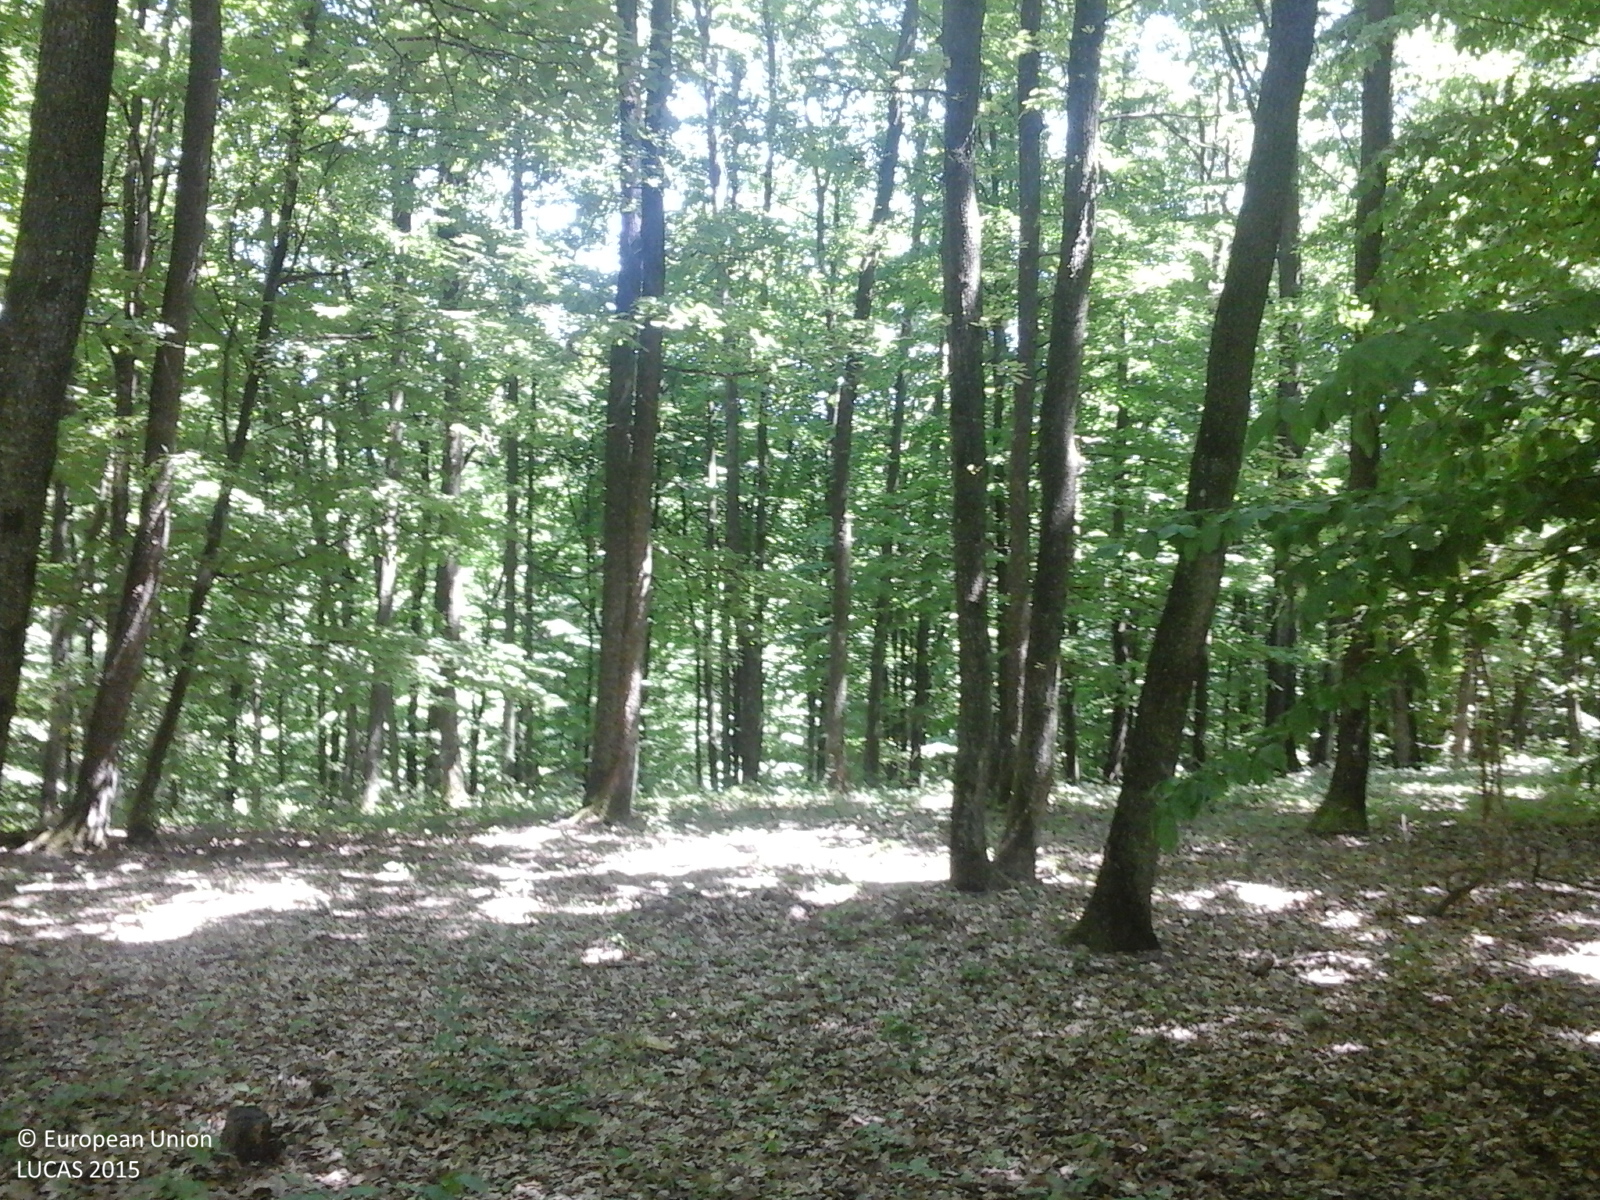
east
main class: Woodland
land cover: Broadleaved woodland
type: acidophilous oak and oak-birch forest
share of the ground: > 75 %
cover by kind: broadleaved forest trees 100 %
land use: Forestry
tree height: > 5 m
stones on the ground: 10 - 25 %
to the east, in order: Broadleaved woodland; Tracks; Broadleaved woodland; Ditches and canals; Broadleaved woodland; Tracks; Broadleaved woodland
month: June
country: RO
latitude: 45.0759
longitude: 26.1562
